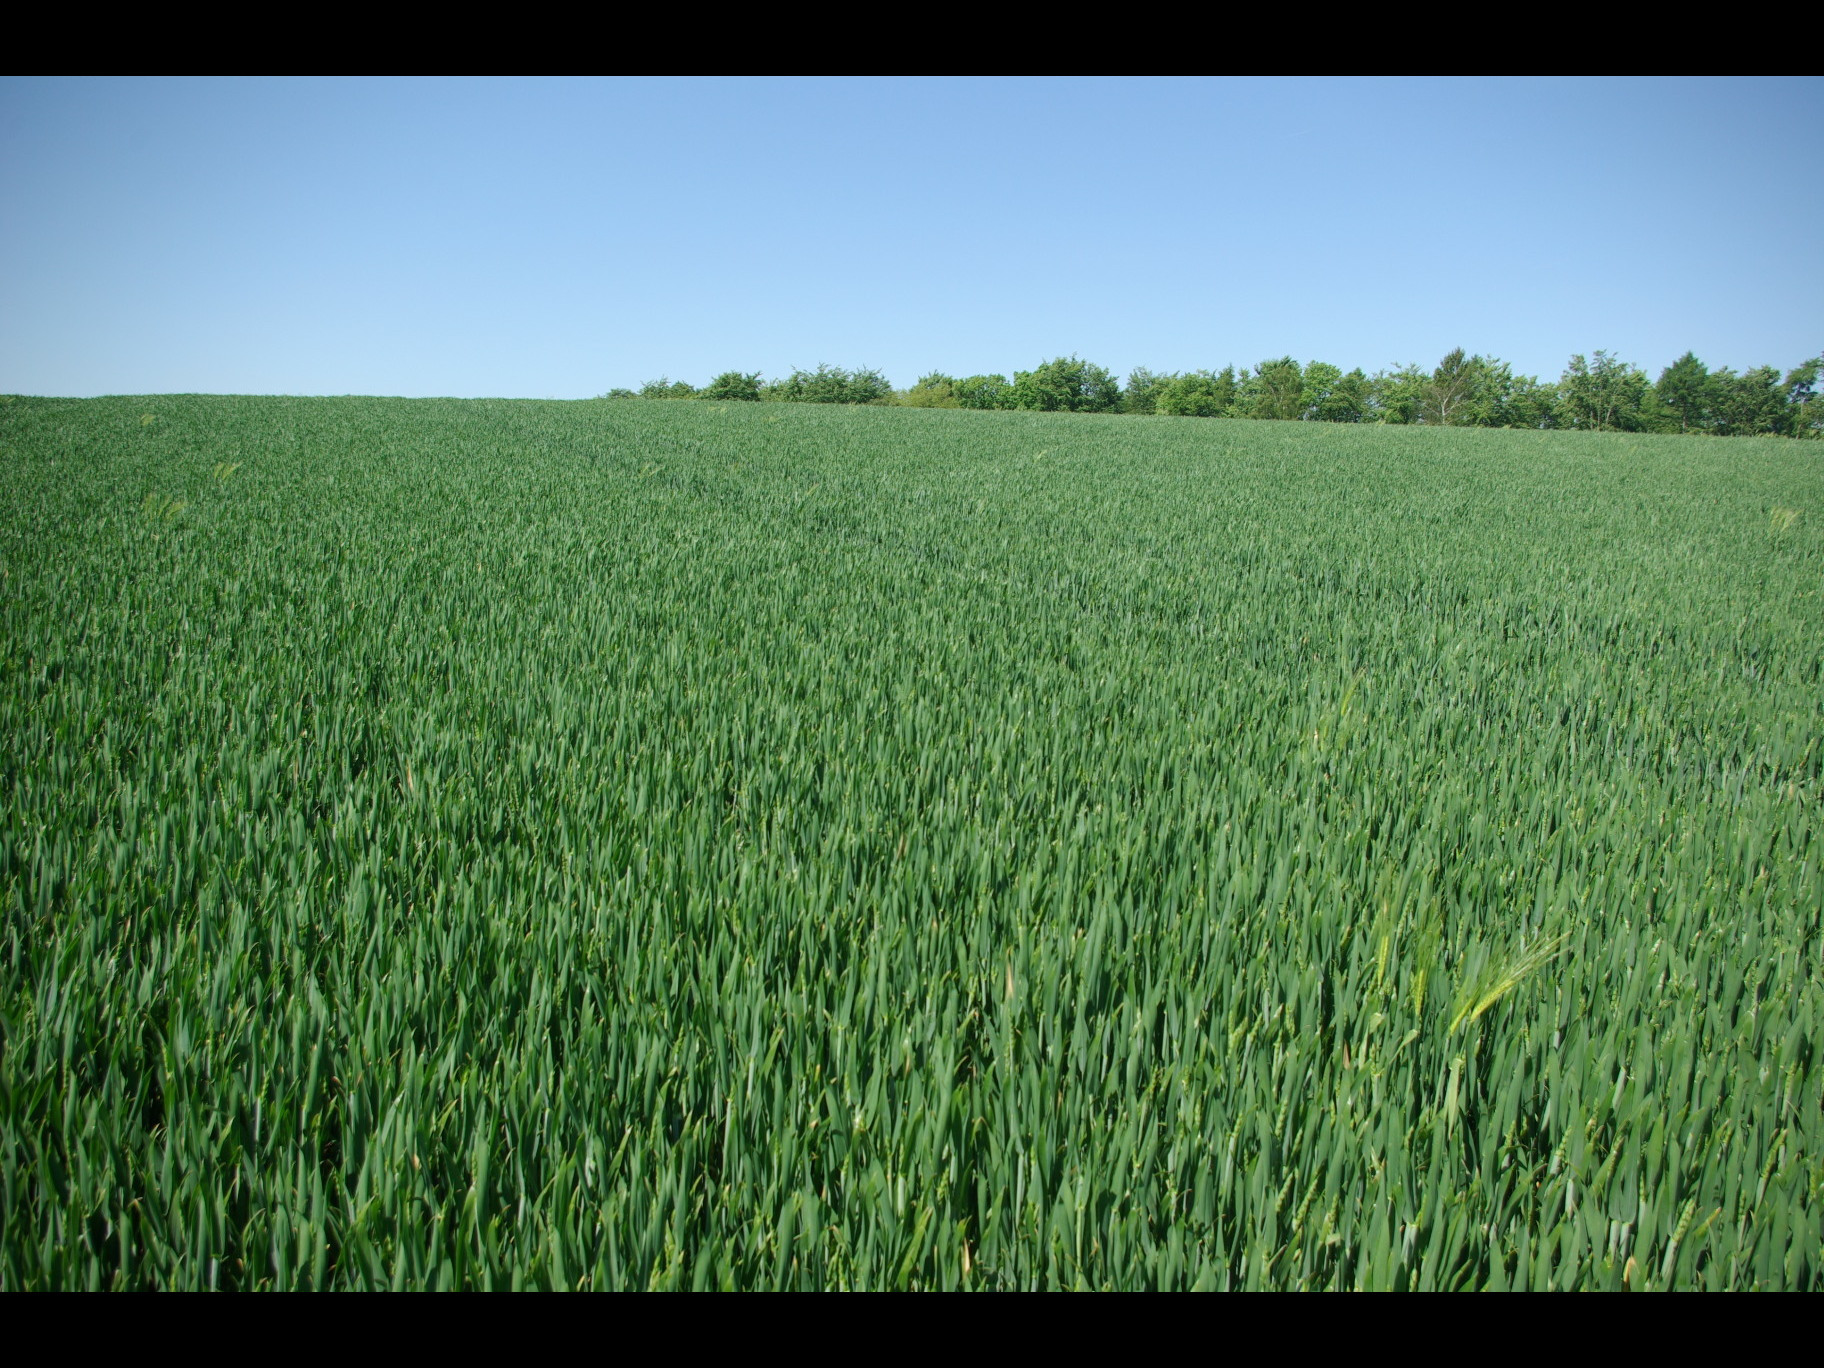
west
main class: Cropland
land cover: Common wheat
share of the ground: > 75 %
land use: Agriculture (excluding fallow land and kitchen gardens)
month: June
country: DE
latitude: 54.1911
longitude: 10.6280
